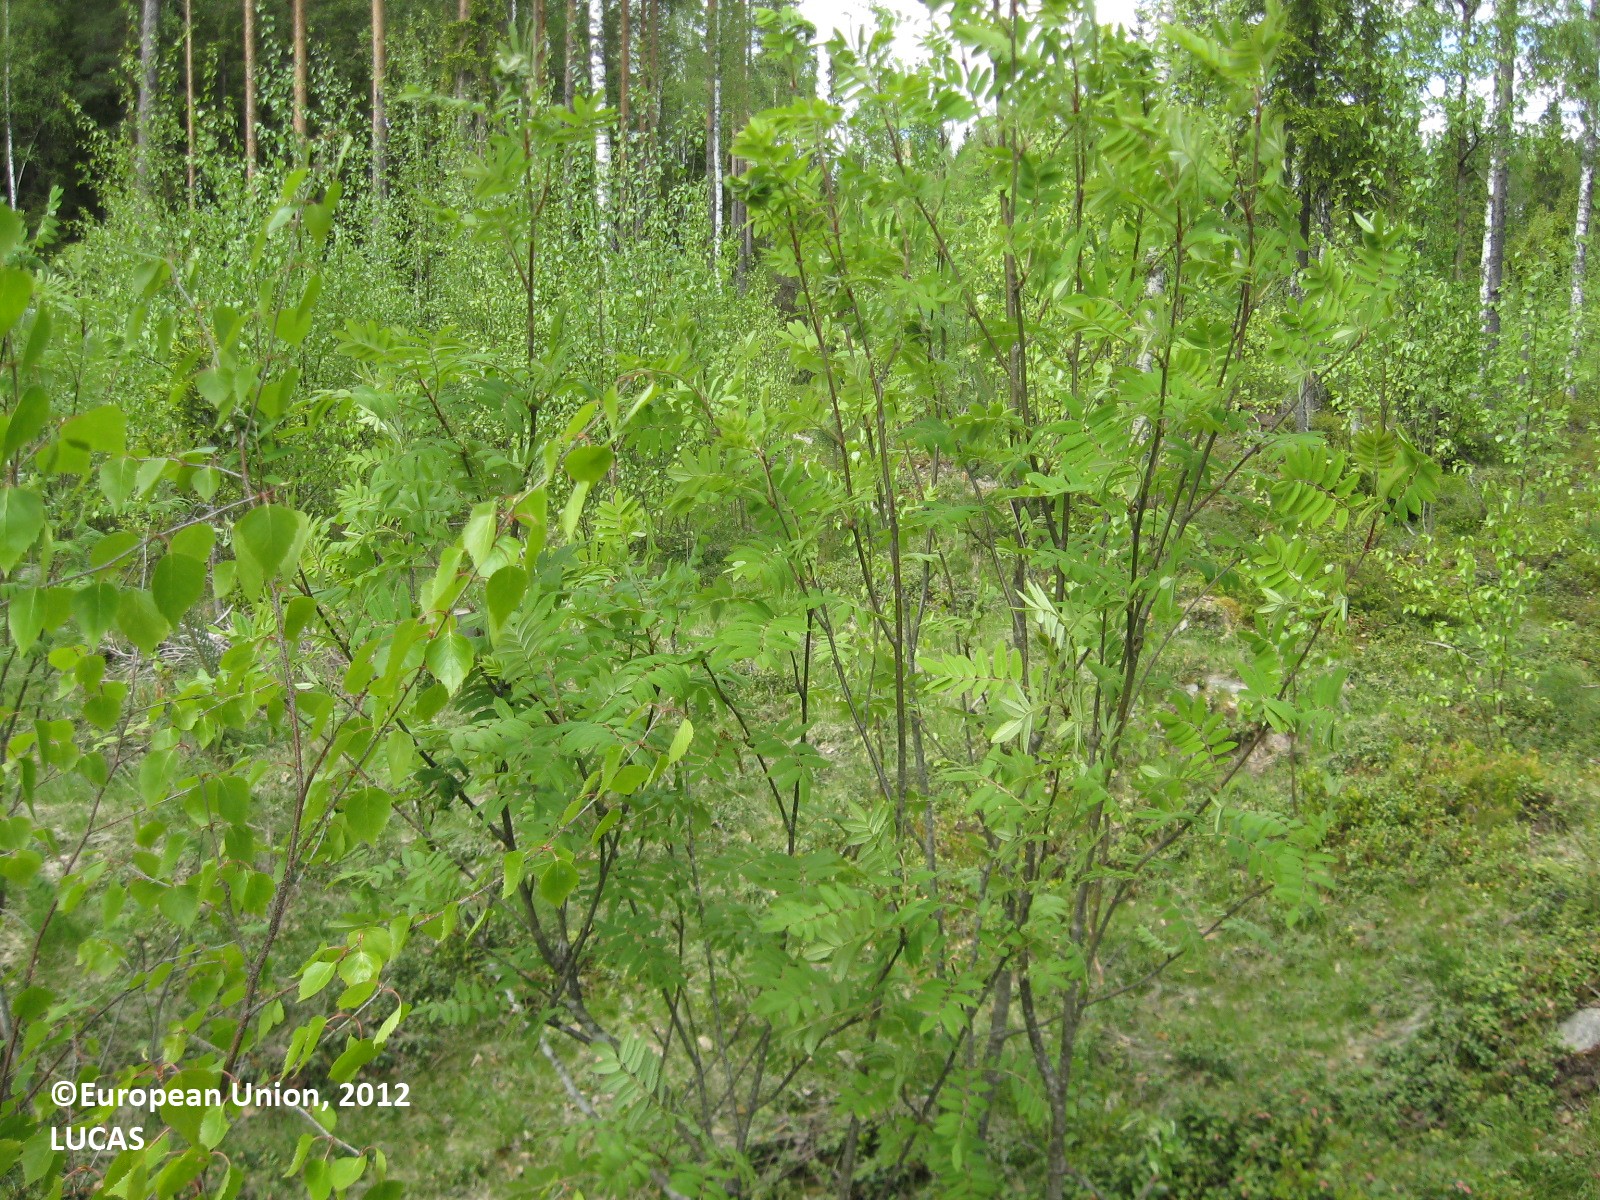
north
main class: Woodland
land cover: Other mixed woodland
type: boreal forest
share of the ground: 25 - 50 %
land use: Forestry
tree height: < 5 m
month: May
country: FI
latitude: 61.8411
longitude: 22.6183
